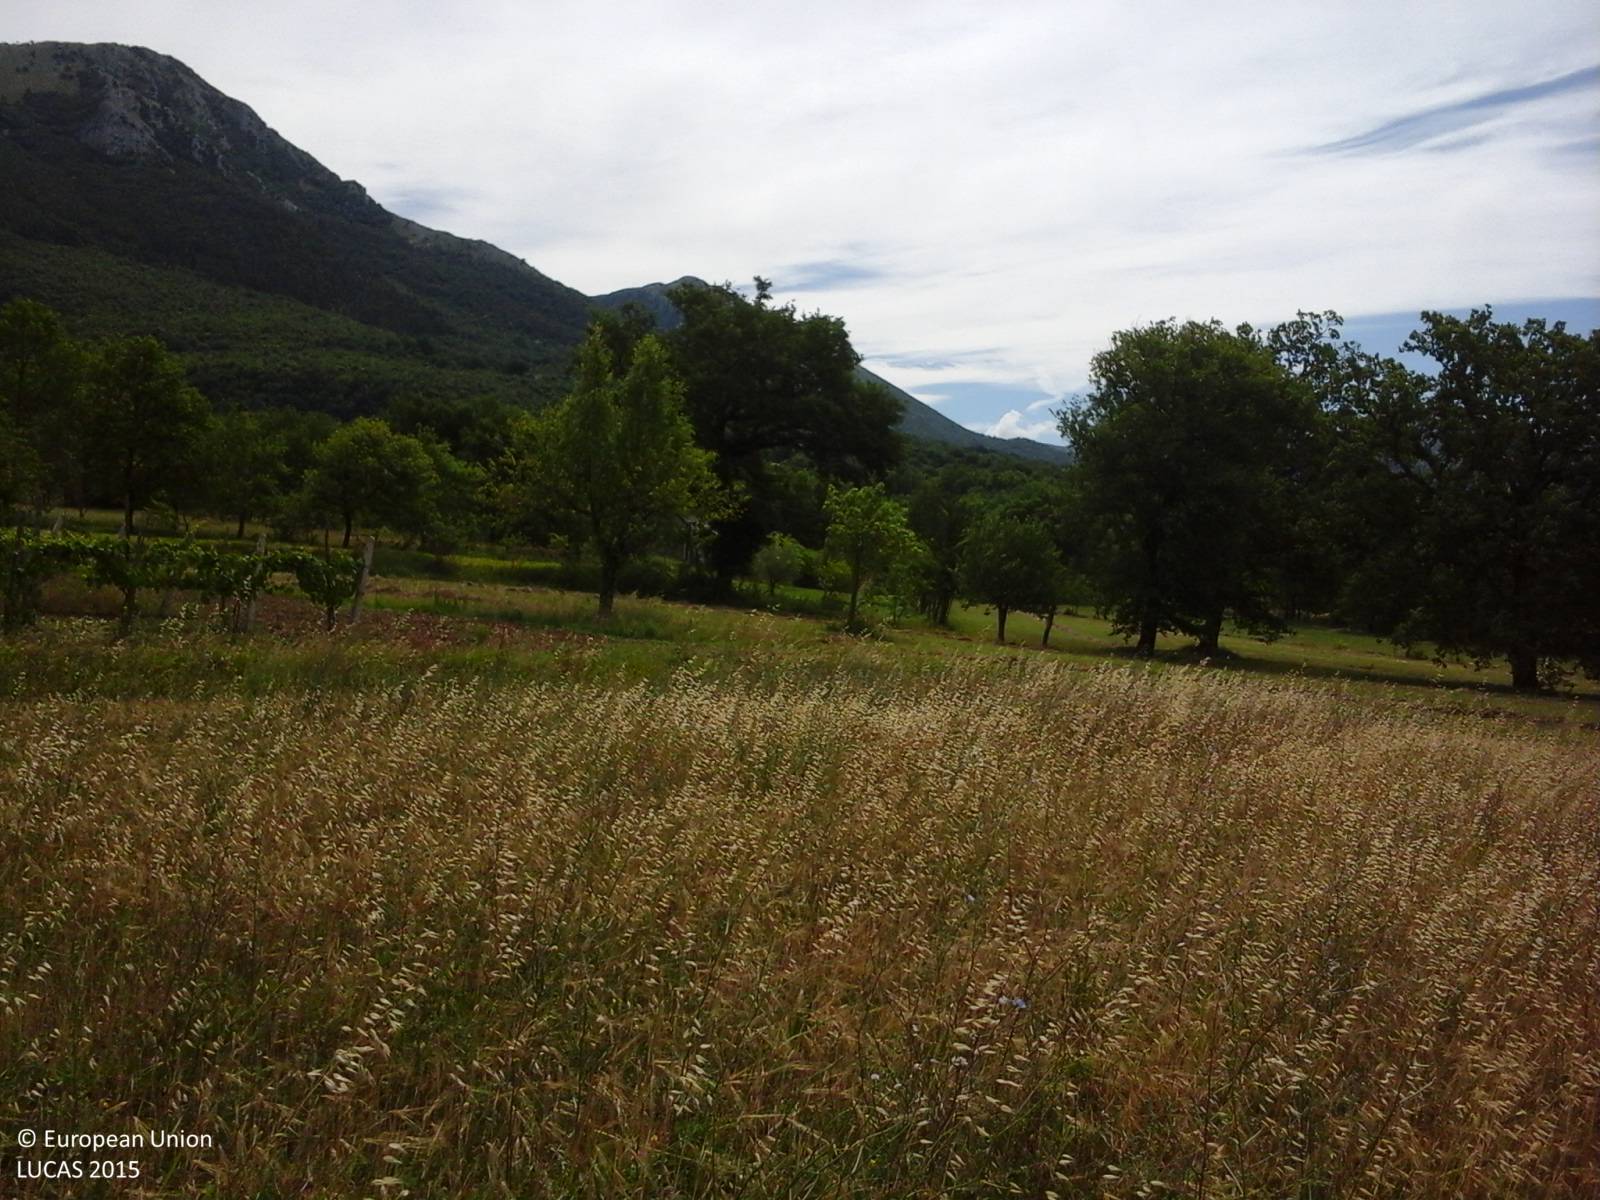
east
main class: Cropland
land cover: Barley
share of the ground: > 75 %
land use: Agriculture (excluding fallow land and kitchen gardens)
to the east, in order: Barley; Grass margins; Vineyards; Spontaneously vegetated surfaces; Ditches and canals; Temporary grasslands; Grass margins; Temporary grasslands; Managed hedges; Temporary grasslands; Managed hedges; Grassland with sparse tree/shrub cover; Shrubland with sparse tree cover; Broadleaved woodland
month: June
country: IT
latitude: 41.4458
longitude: 14.1858
